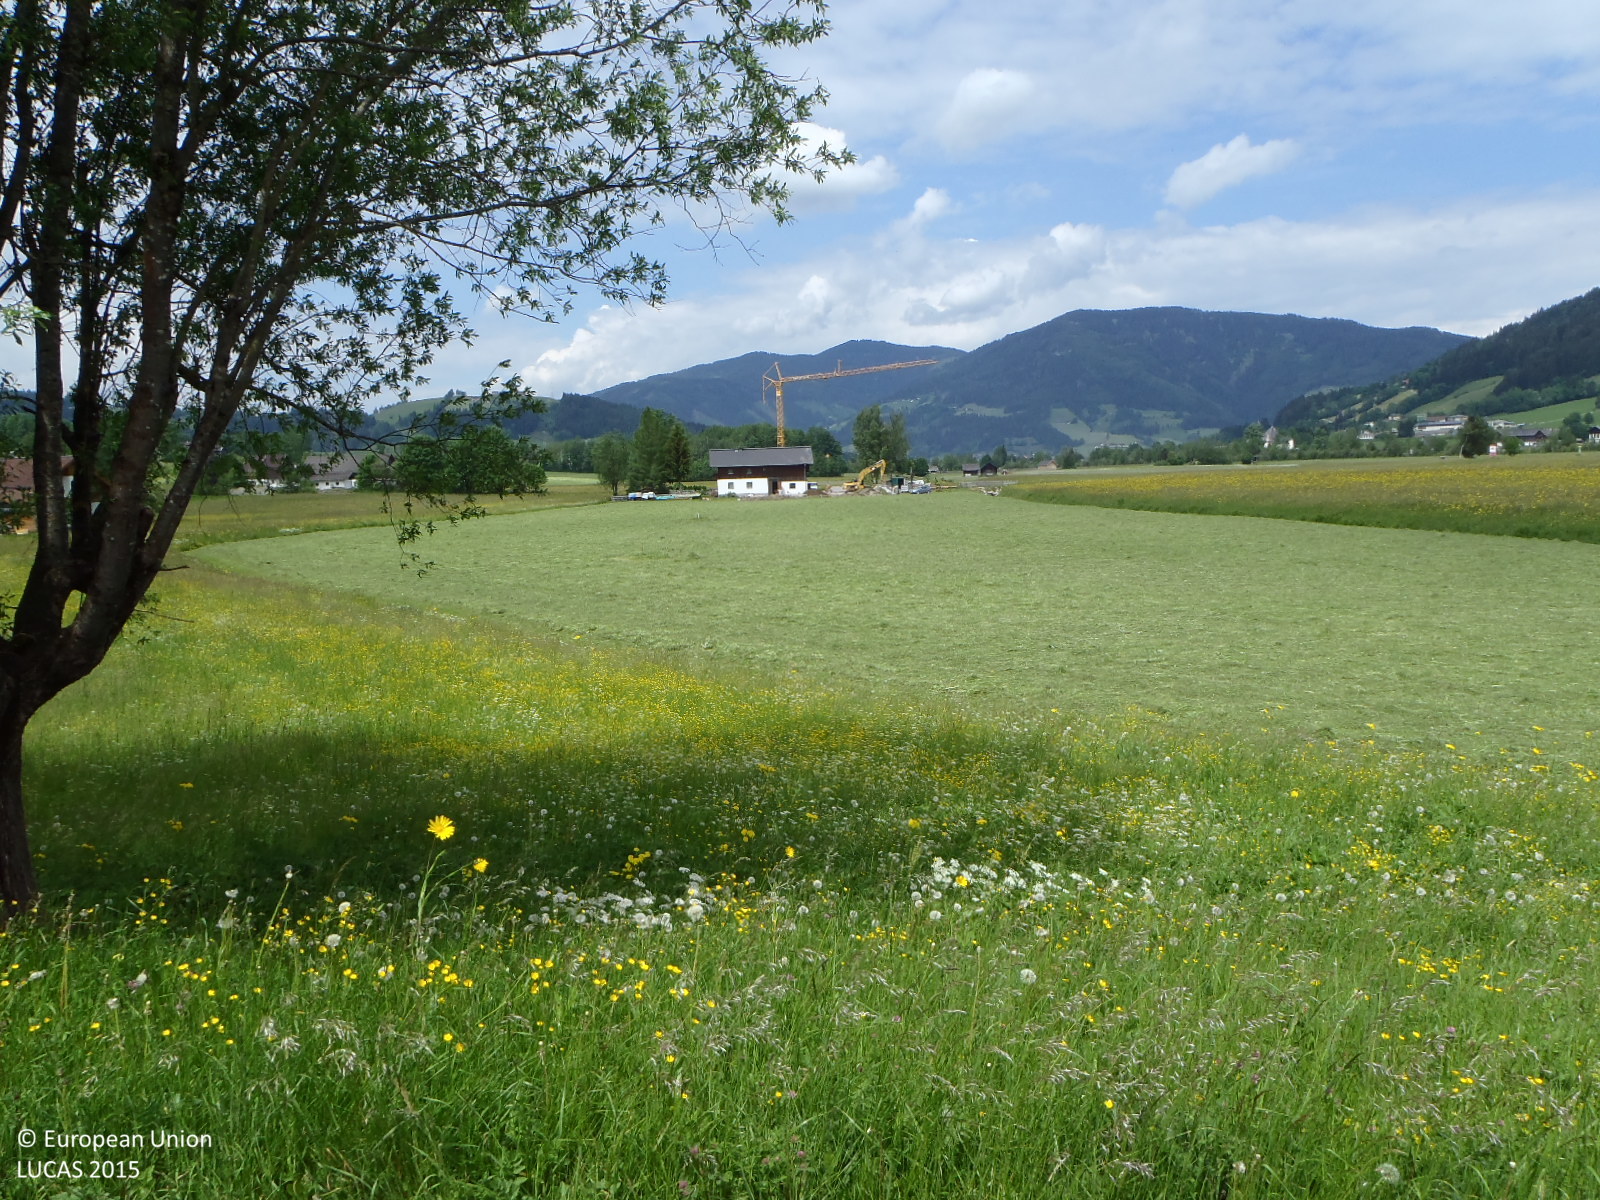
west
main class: Grassland
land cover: Grassland without tree/shrub cover
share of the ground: > 75 %
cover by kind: herbaceous plants 100 %
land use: Agriculture (excluding fallow land and kitchen gardens)
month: June
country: AT
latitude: 47.3768
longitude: 13.4550
